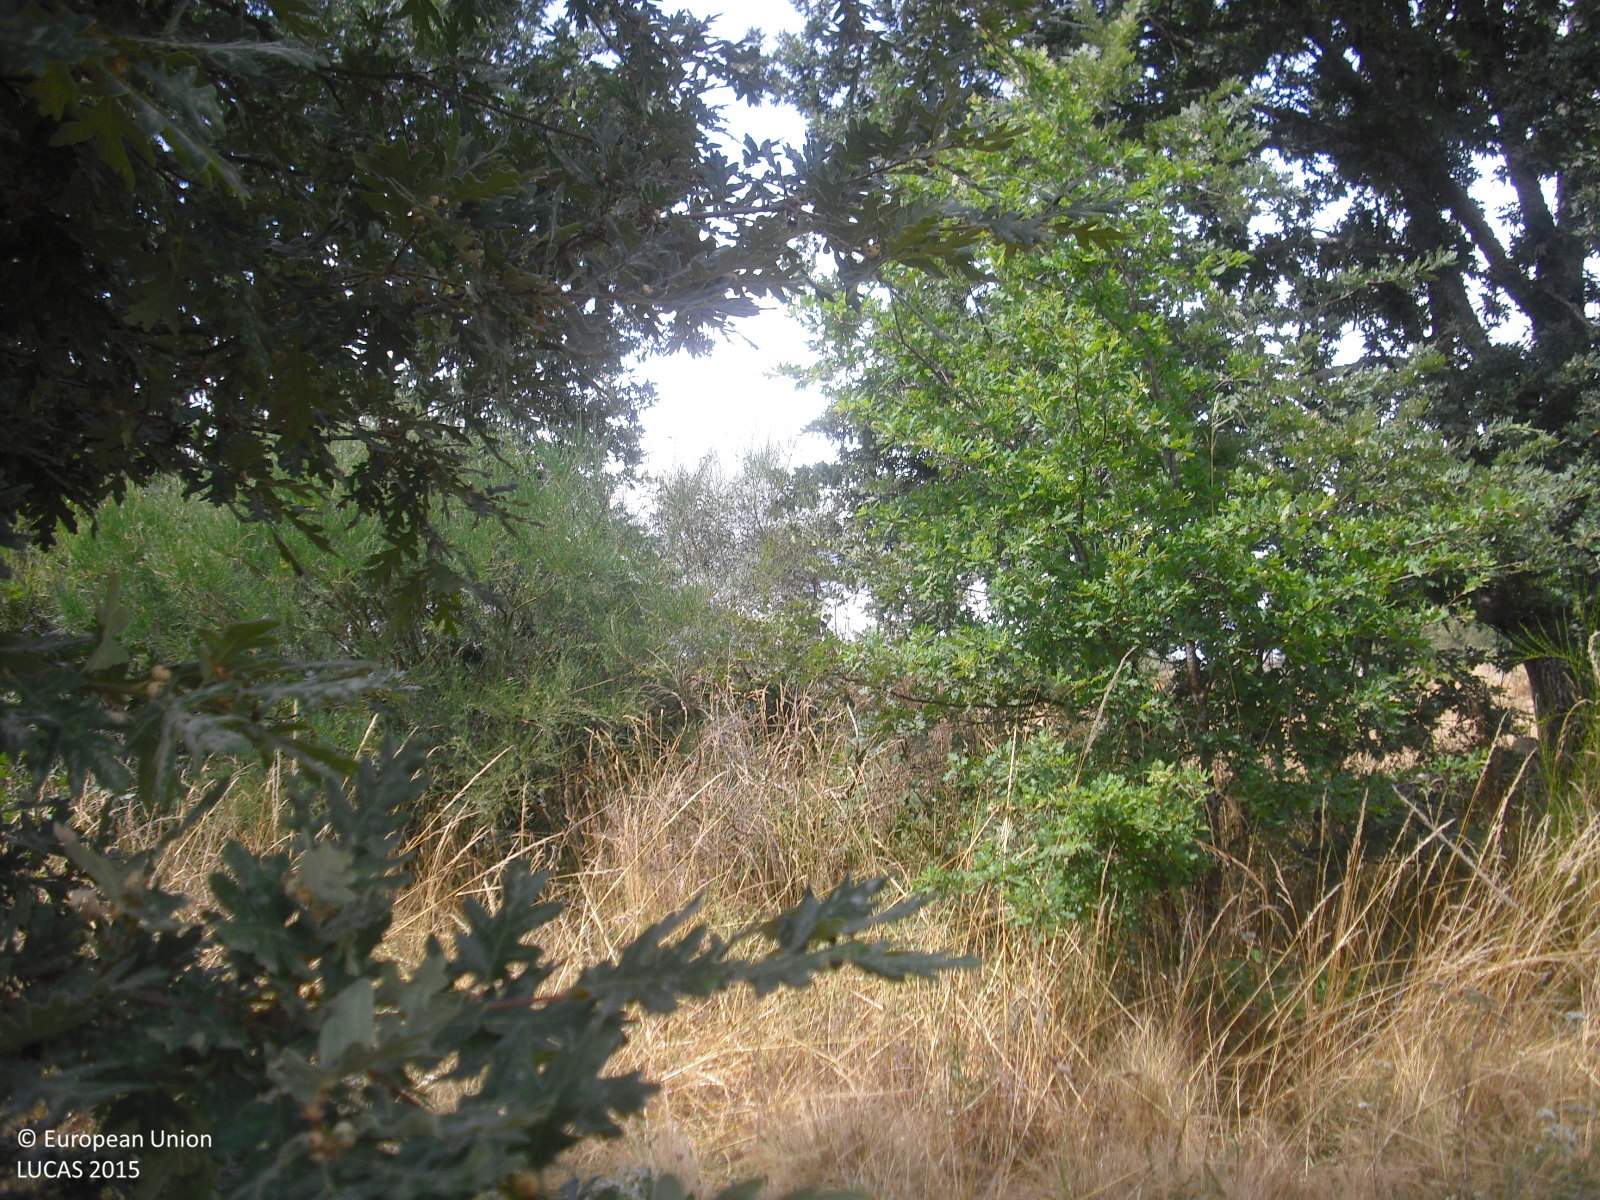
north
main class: Grassland
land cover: Grassland with sparse tree/shrub cover
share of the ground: > 75 %
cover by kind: herbaceous plants 95 %, broadleaved forest trees 5 %
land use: Abandoned areas
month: July
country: ES
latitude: 42.3486
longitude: -7.4118
